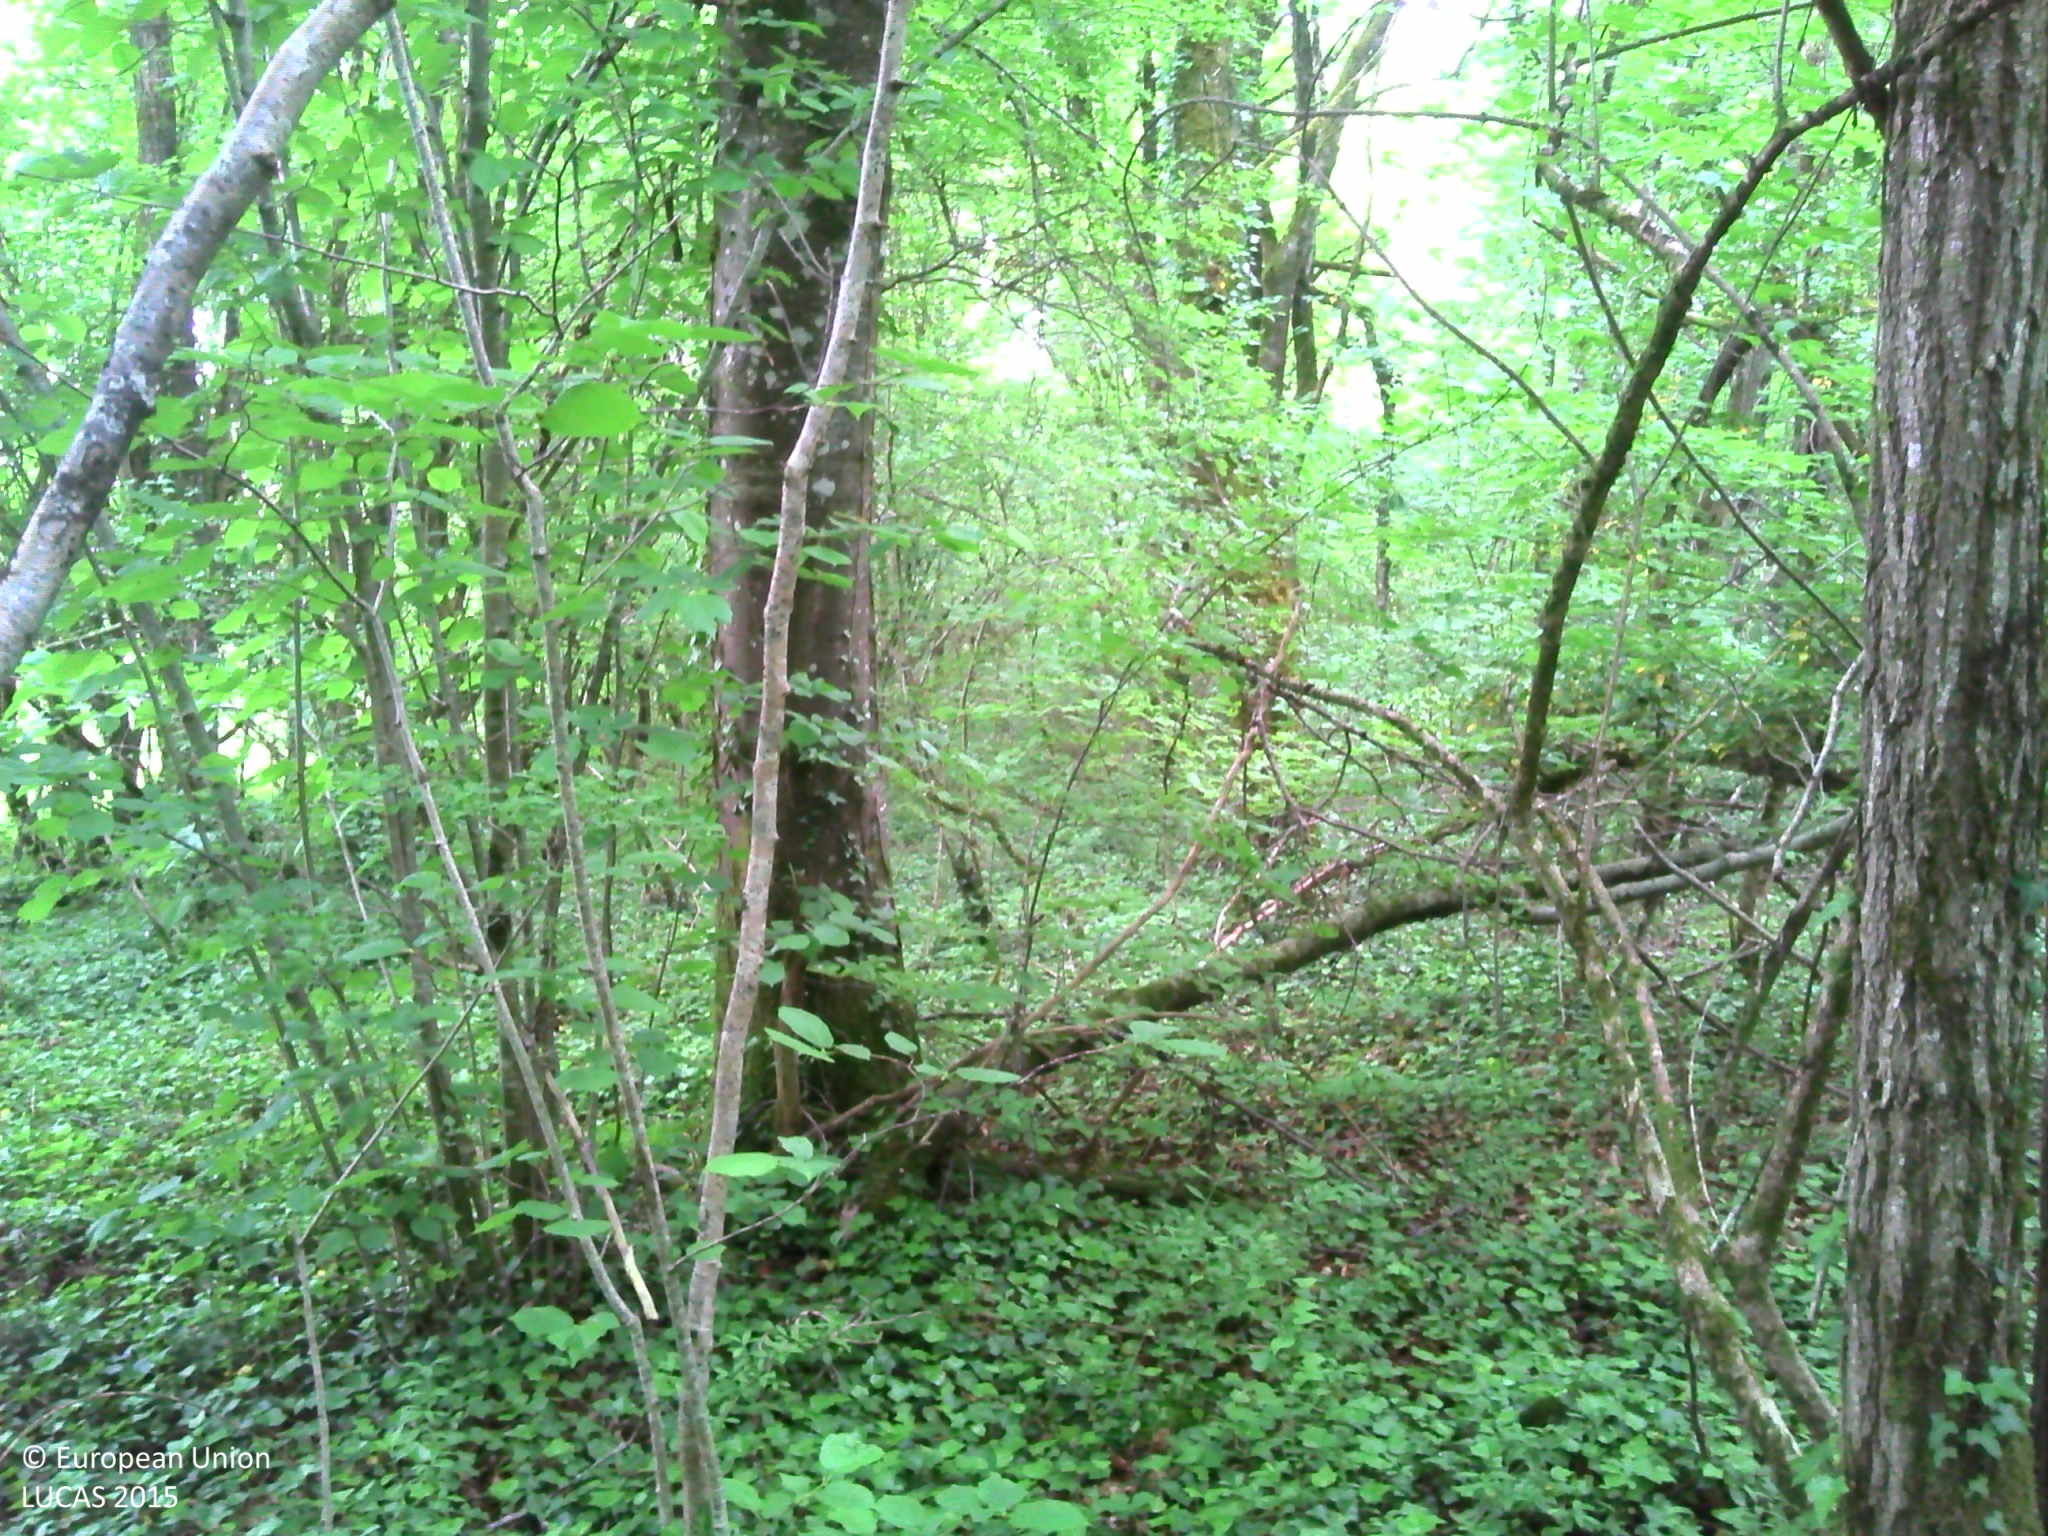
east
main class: Woodland
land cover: Broadleaved woodland
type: acidophilous oak and oak-birch forest
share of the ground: > 75 %
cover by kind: broadleaved forest trees 90 %, herbaceous plants 5 %, lichens and mosses 5 %
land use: Forestry
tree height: > 5 m
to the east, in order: Broadleaved woodland; Fences; Grassland without tree/shrub cover; Single bushes/trees; Grassland without tree/shrub cover; Fences; Managed hedges; Ditches and canals; Barley
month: May
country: FR
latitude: 47.7860
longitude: 4.2718
